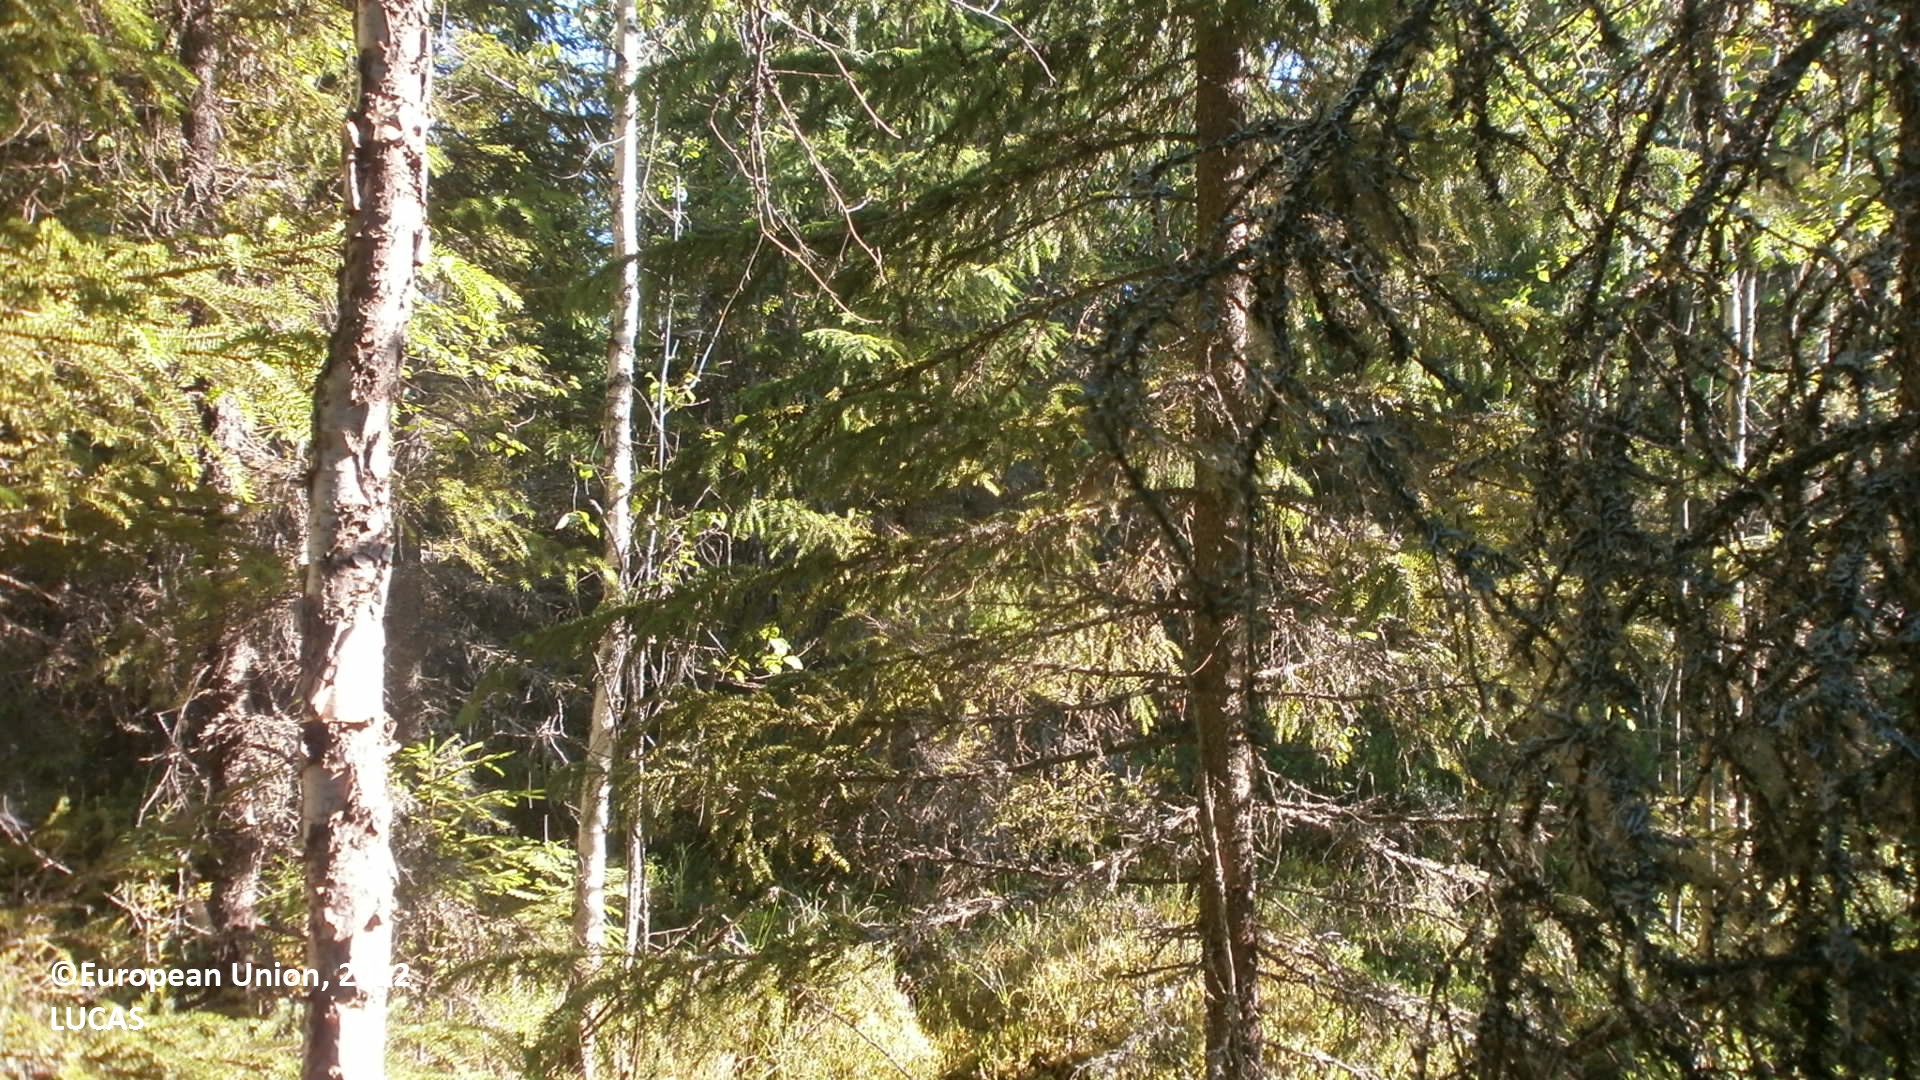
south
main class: Woodland
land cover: Spruce dominated coniferous woodland
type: boreal forest
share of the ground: > 75 %
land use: Forestry
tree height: > 5 m
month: July
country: FI
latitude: 64.0723
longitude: 24.9444
